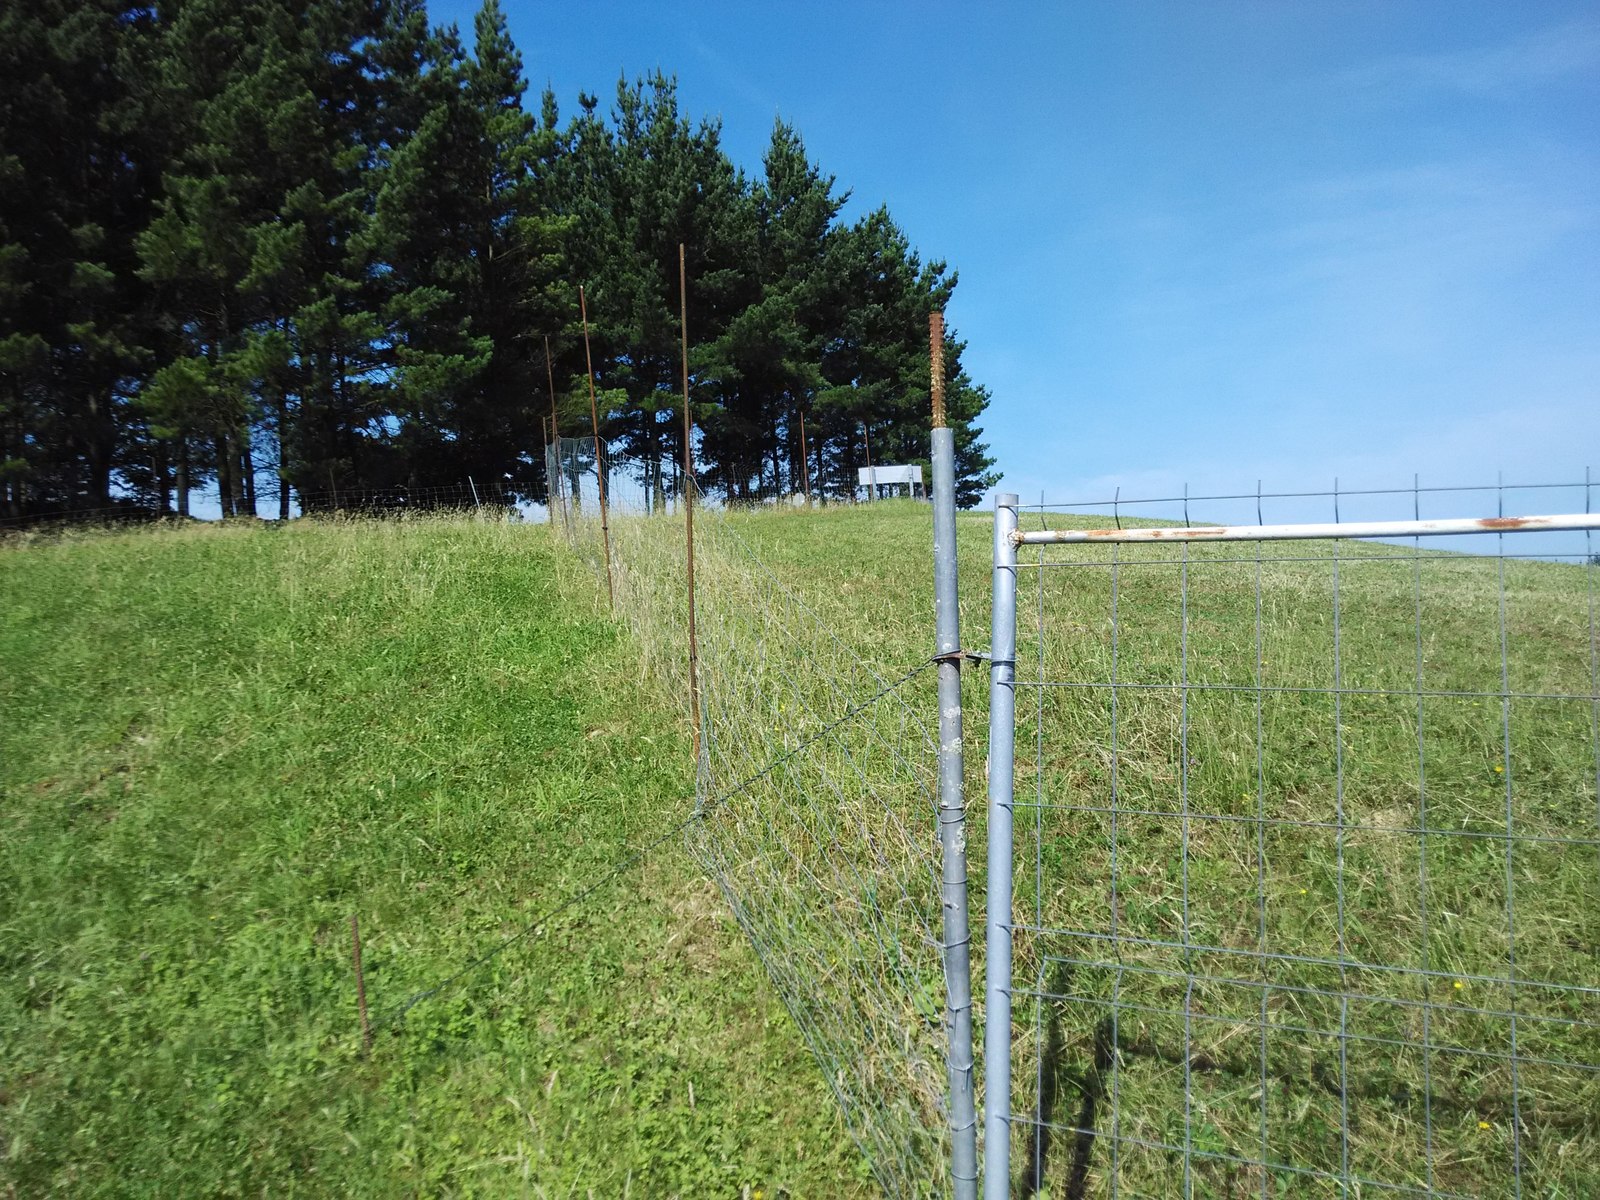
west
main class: Grassland
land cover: Grassland without tree/shrub cover
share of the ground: > 75 %
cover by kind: herbaceous plants 90 %, unconsolidated bare surface 10 %
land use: Agriculture (excluding fallow land and kitchen gardens)
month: July
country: ES
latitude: 43.1645
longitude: -2.2626
